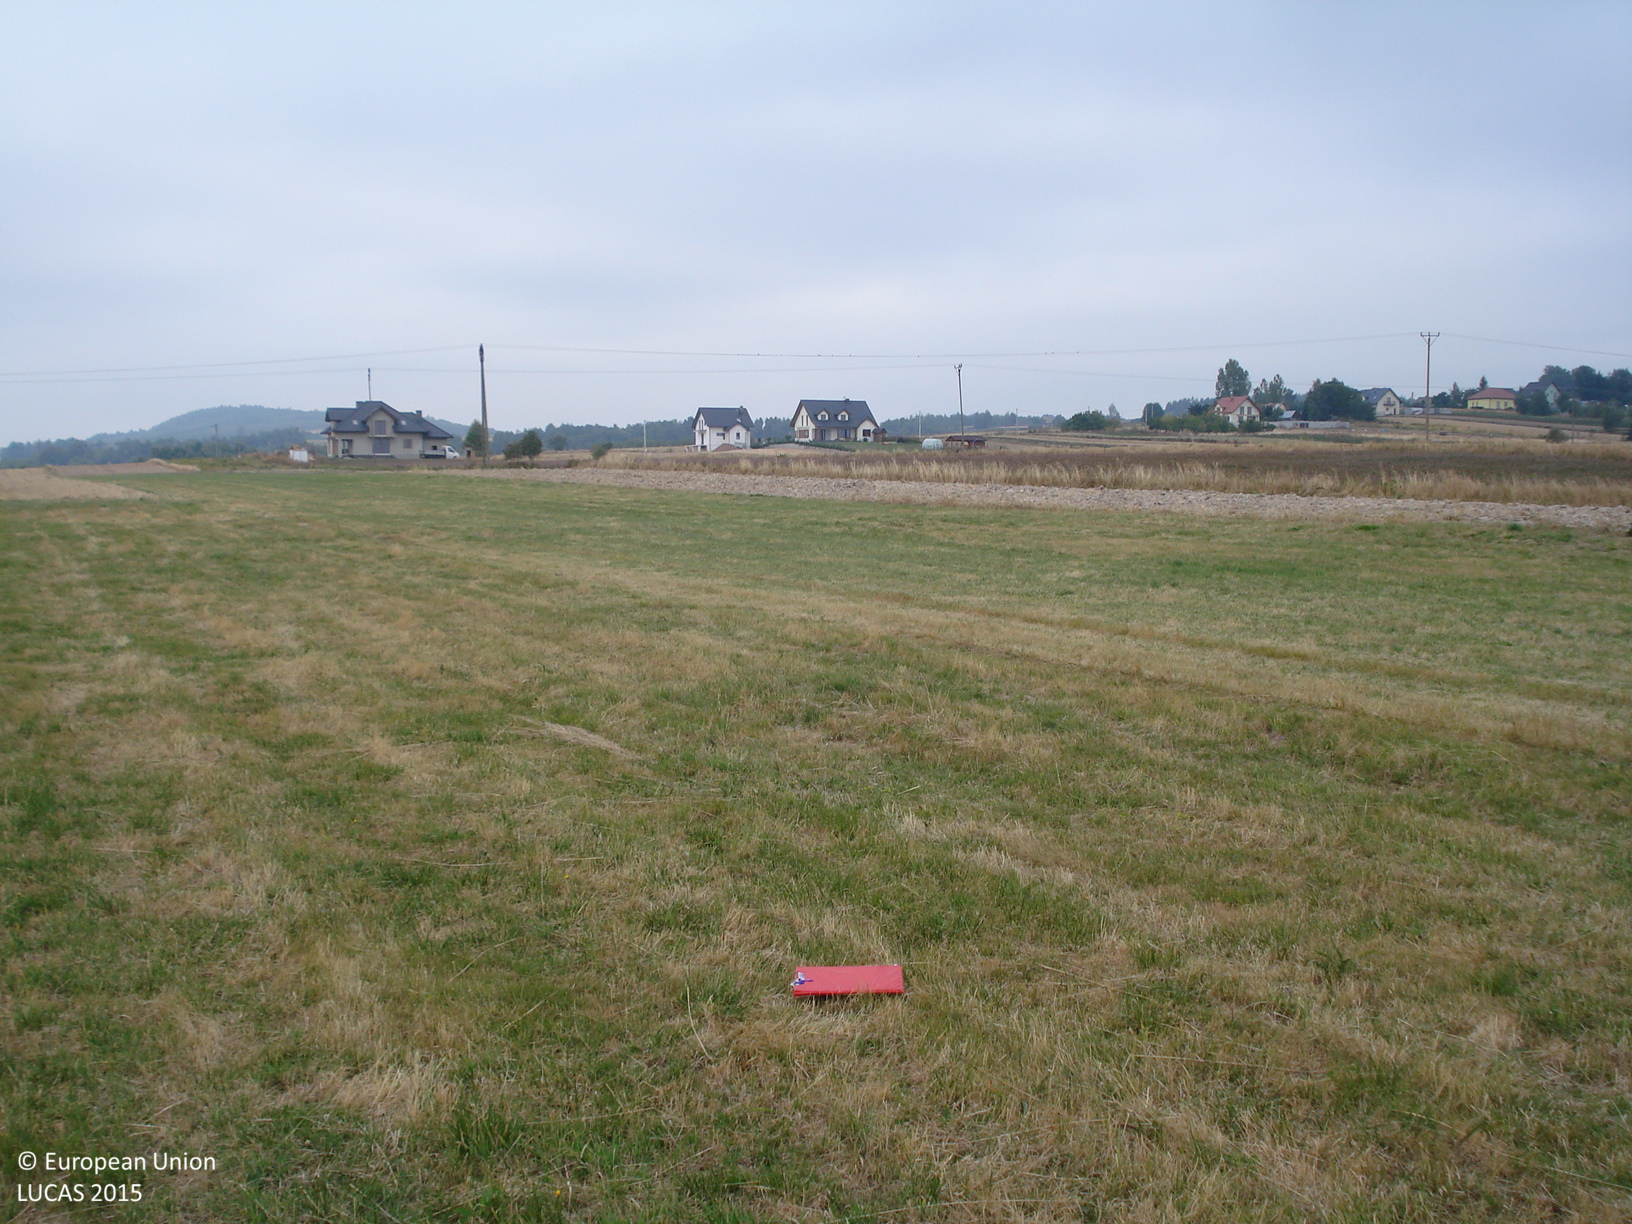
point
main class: Grassland
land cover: Grassland without tree/shrub cover
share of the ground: > 75 %
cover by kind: herbaceous plants 100 %
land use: Agriculture (excluding fallow land and kitchen gardens)
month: September
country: PL
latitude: 50.8824
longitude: 20.8304
